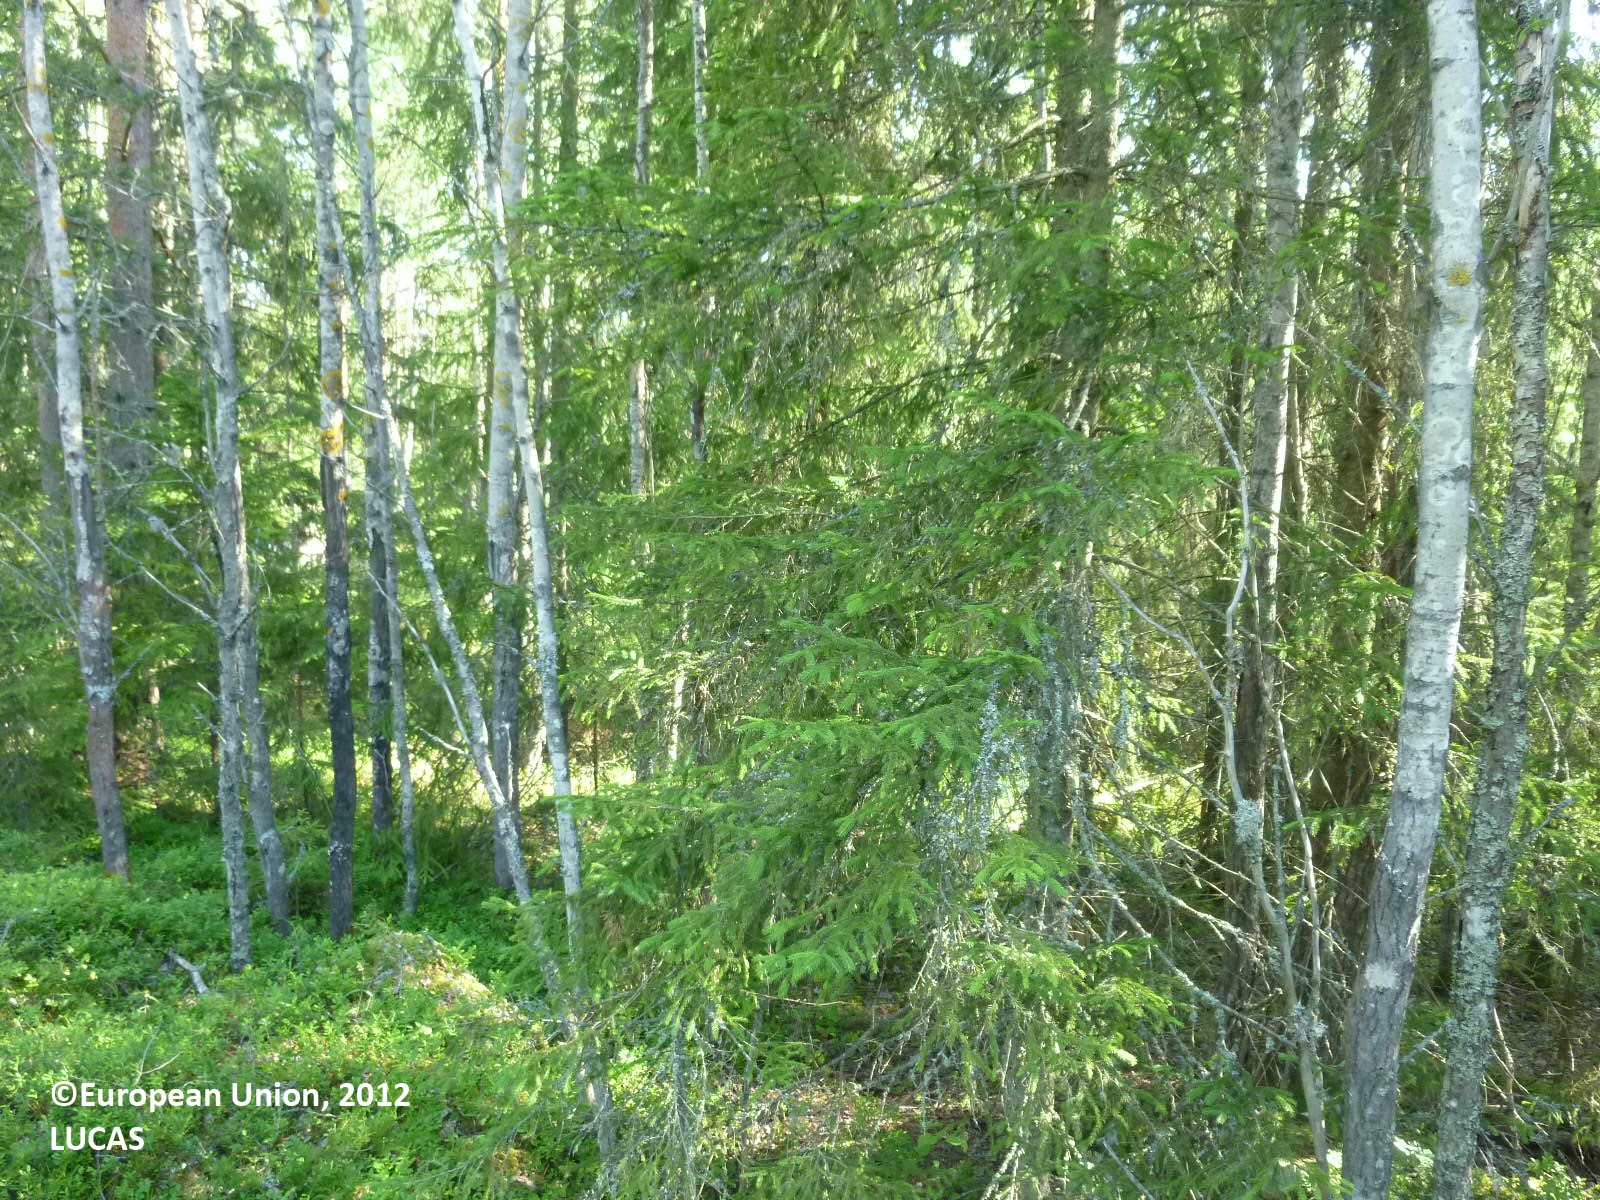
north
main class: Woodland
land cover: Pine dominated mixed woodland
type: boreal forest
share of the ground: 25 - 50 %
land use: Forestry
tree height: > 5 m
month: July
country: FI
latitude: 61.1680
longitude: 22.5773
